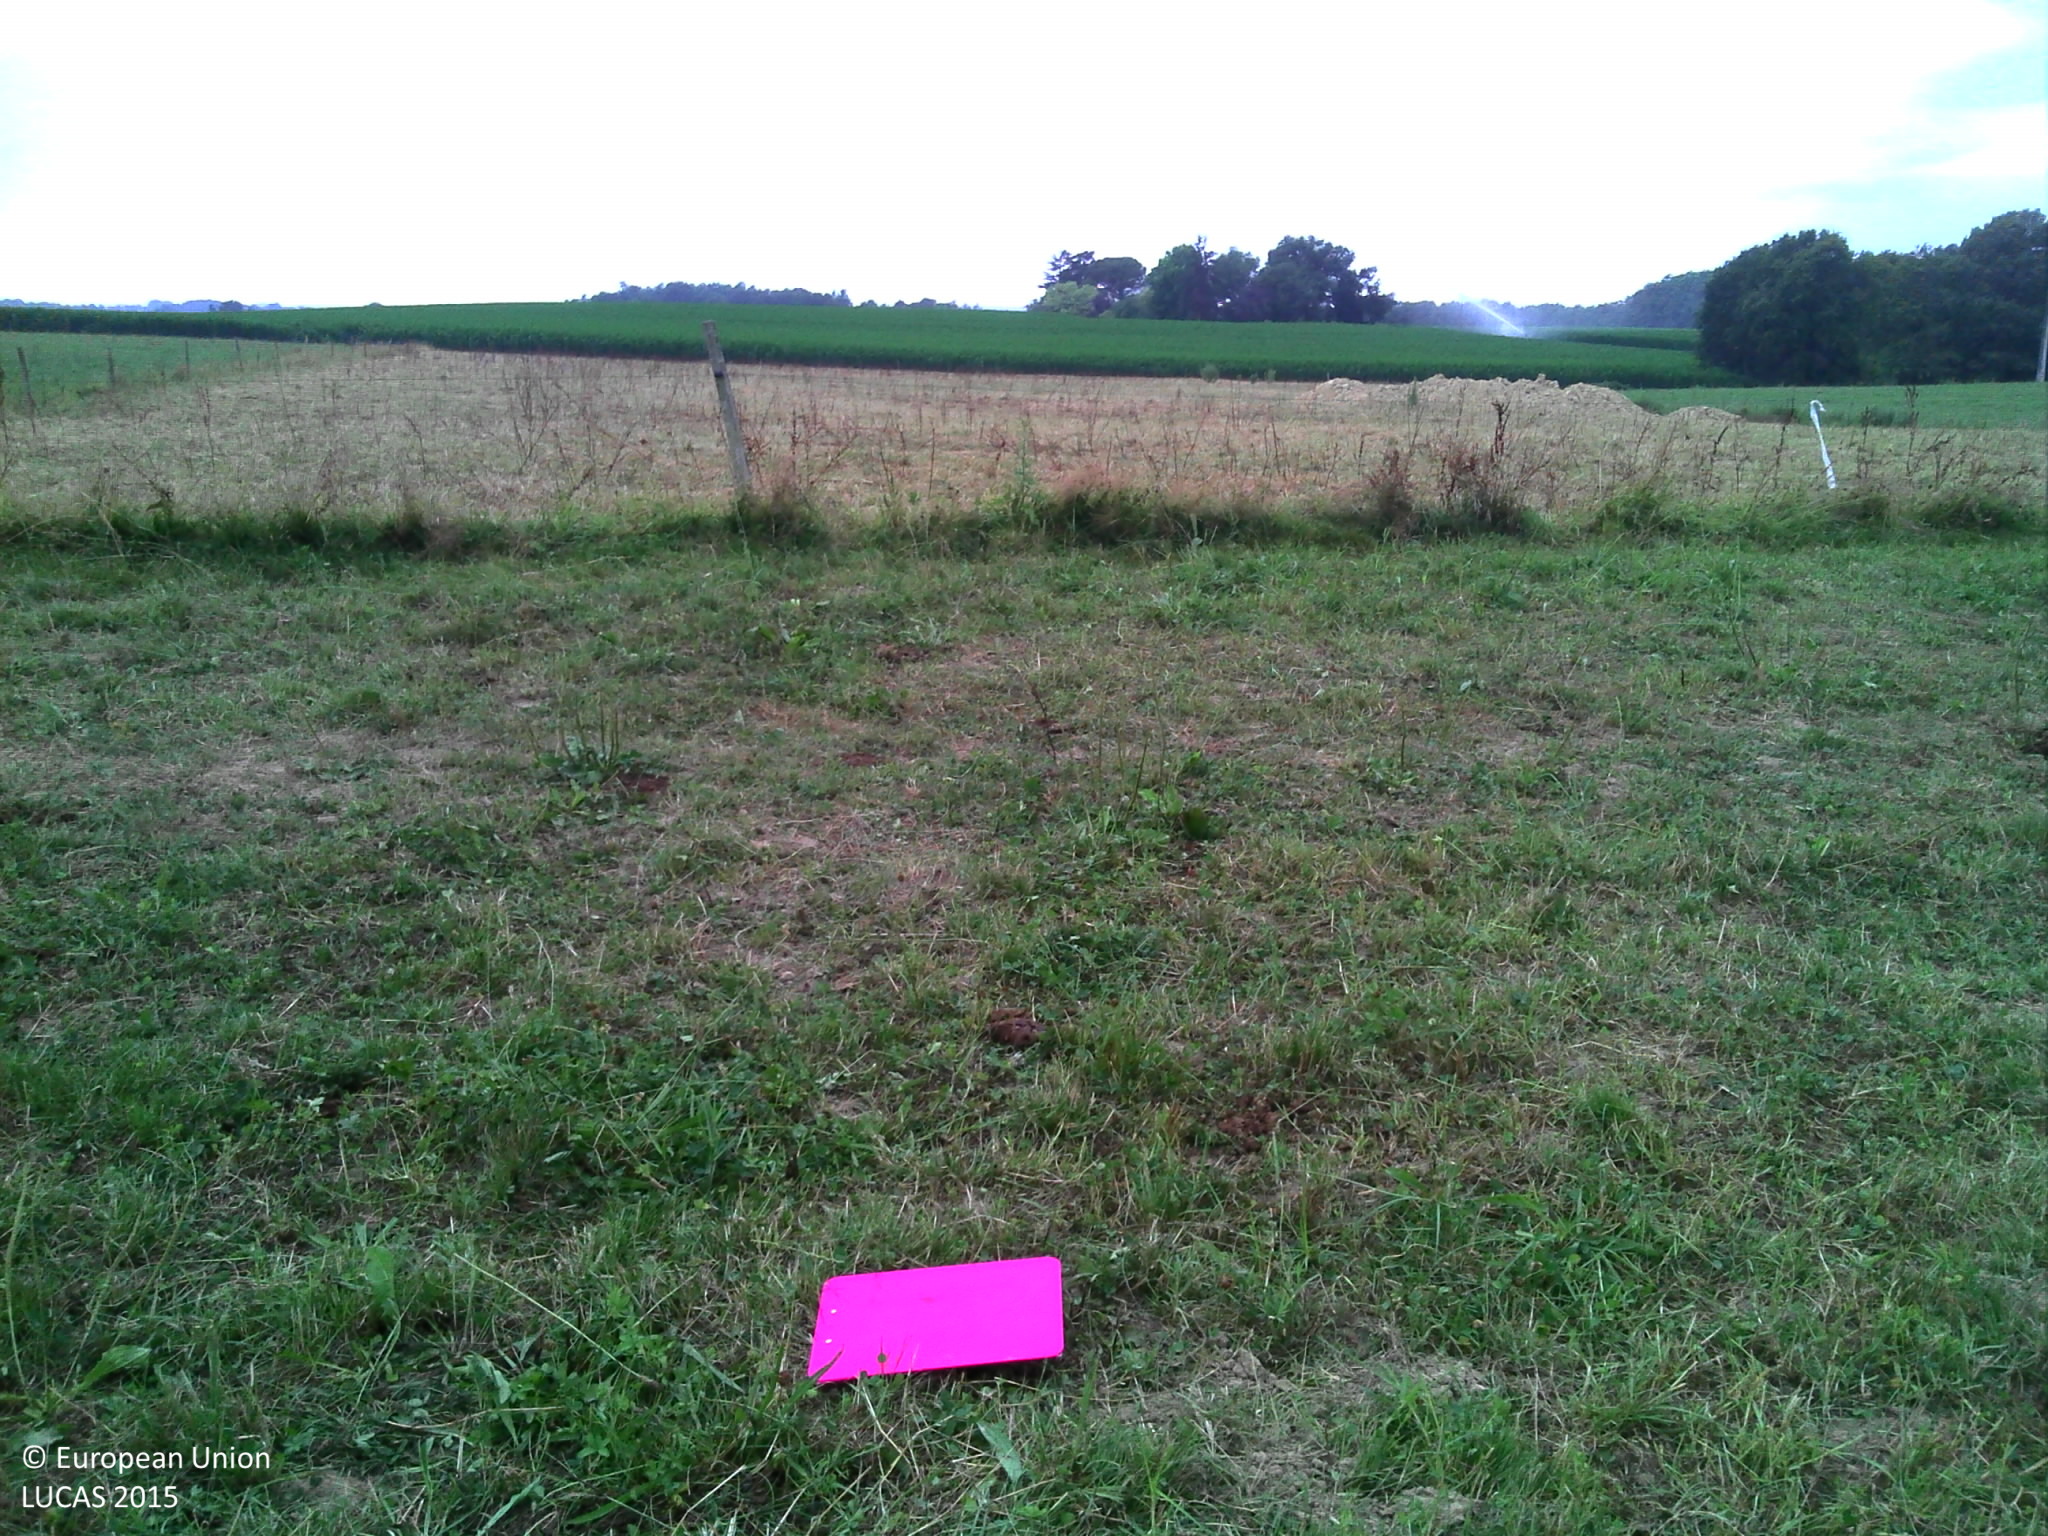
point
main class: Grassland
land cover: Grassland without tree/shrub cover
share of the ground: > 75 %
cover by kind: herbaceous plants 90 %, unconsolidated bare surface 10 %
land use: Agriculture (excluding fallow land and kitchen gardens)
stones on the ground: < 10 %
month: July
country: FR
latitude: 43.6375
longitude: -1.1599
